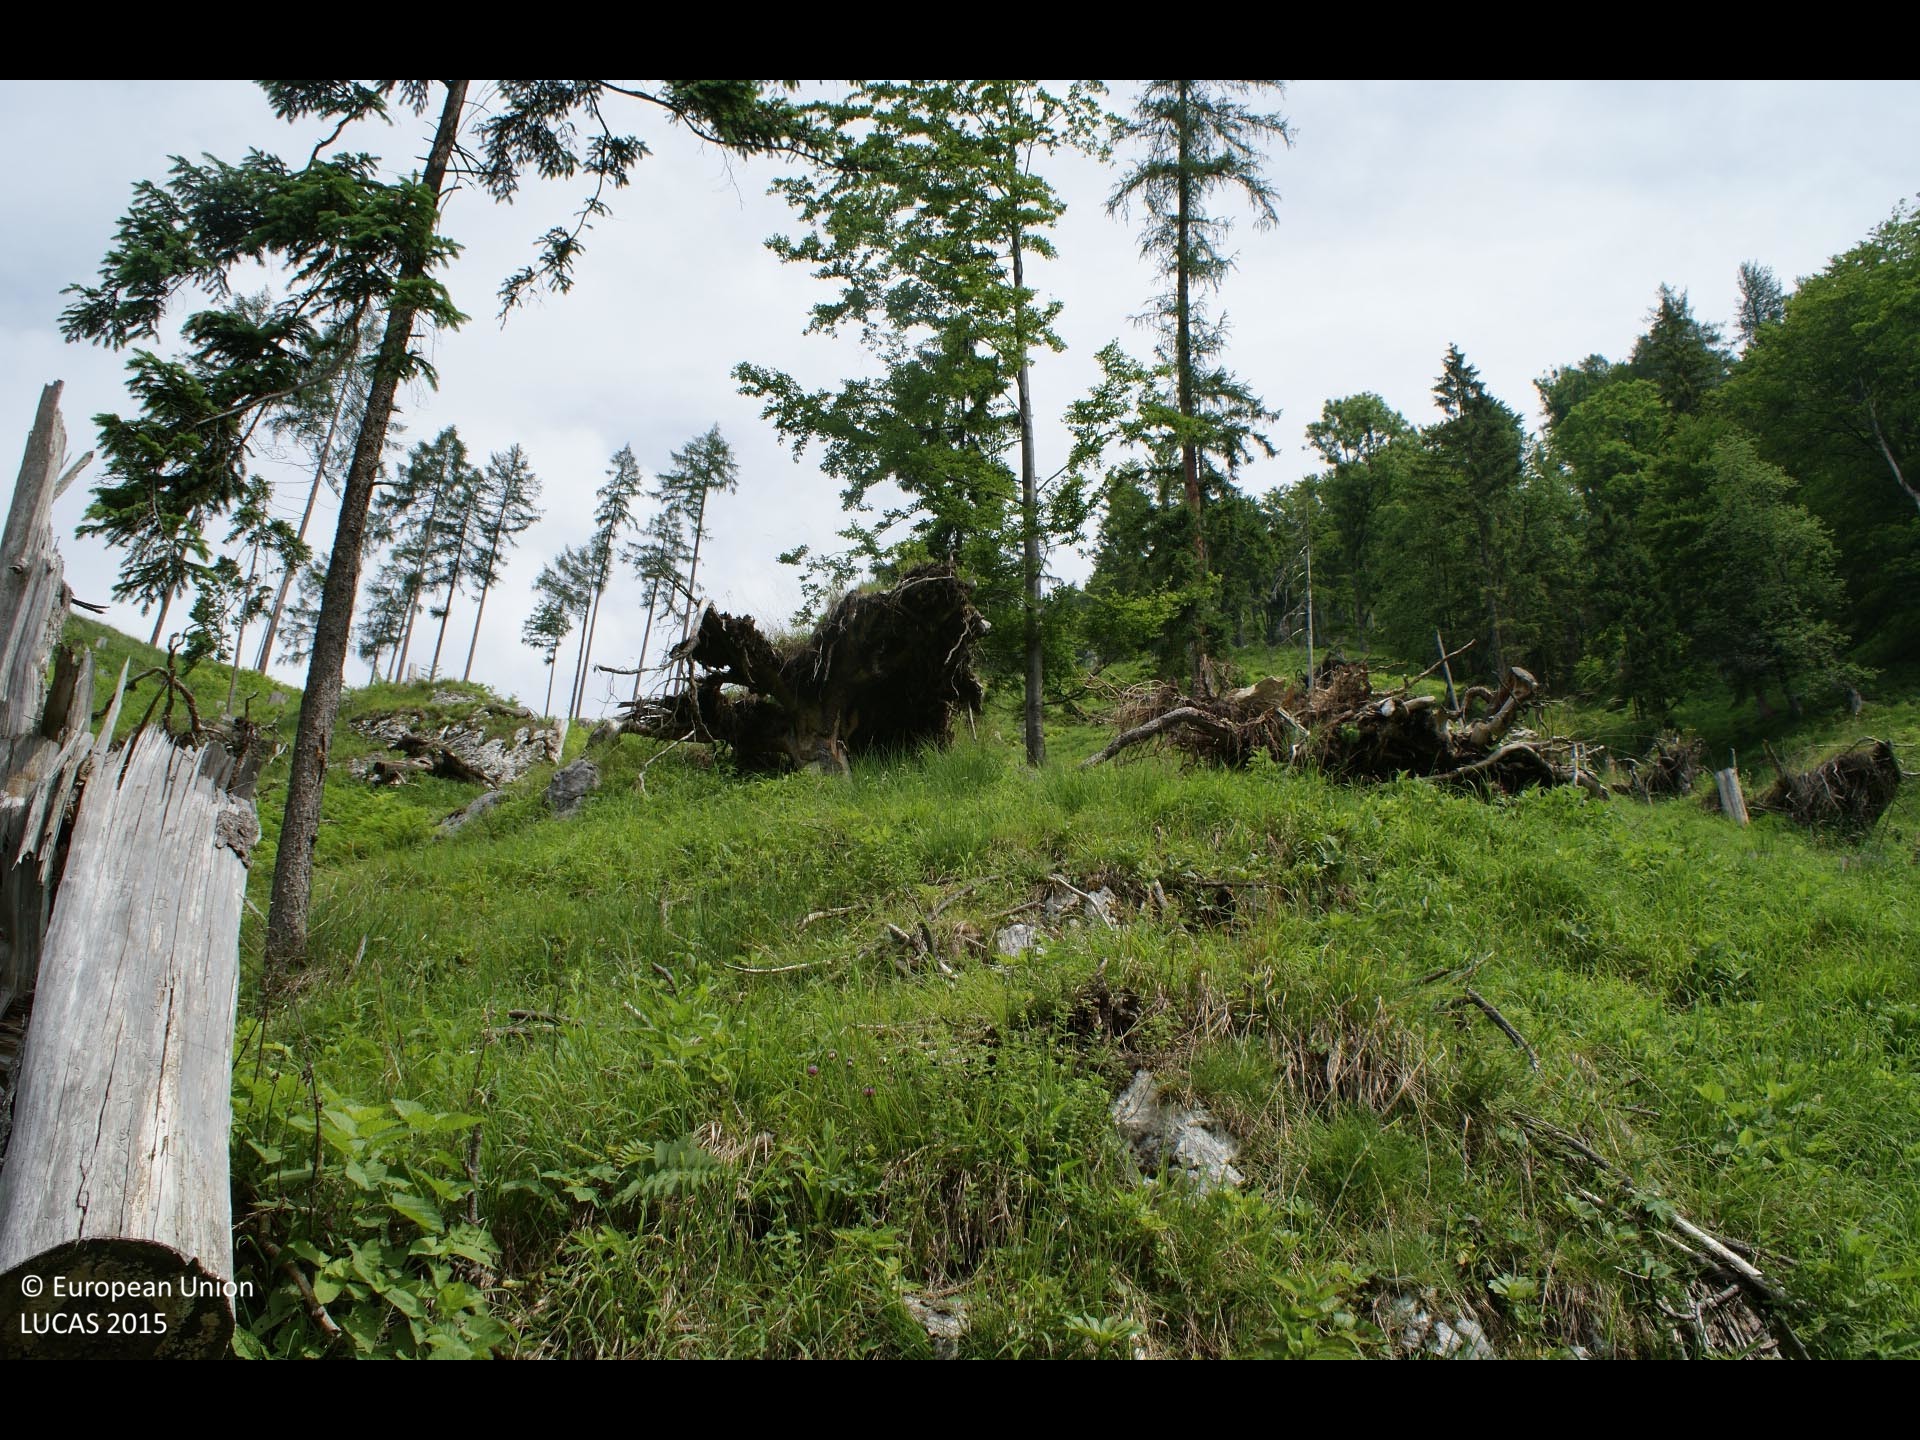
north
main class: Grassland
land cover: Spontaneously vegetated surfaces
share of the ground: > 75 %
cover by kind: herbaceous plants 95 %, shrubs 5 %
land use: Forestry
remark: Clear cut
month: June
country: AT
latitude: 47.8220
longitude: 14.1265
